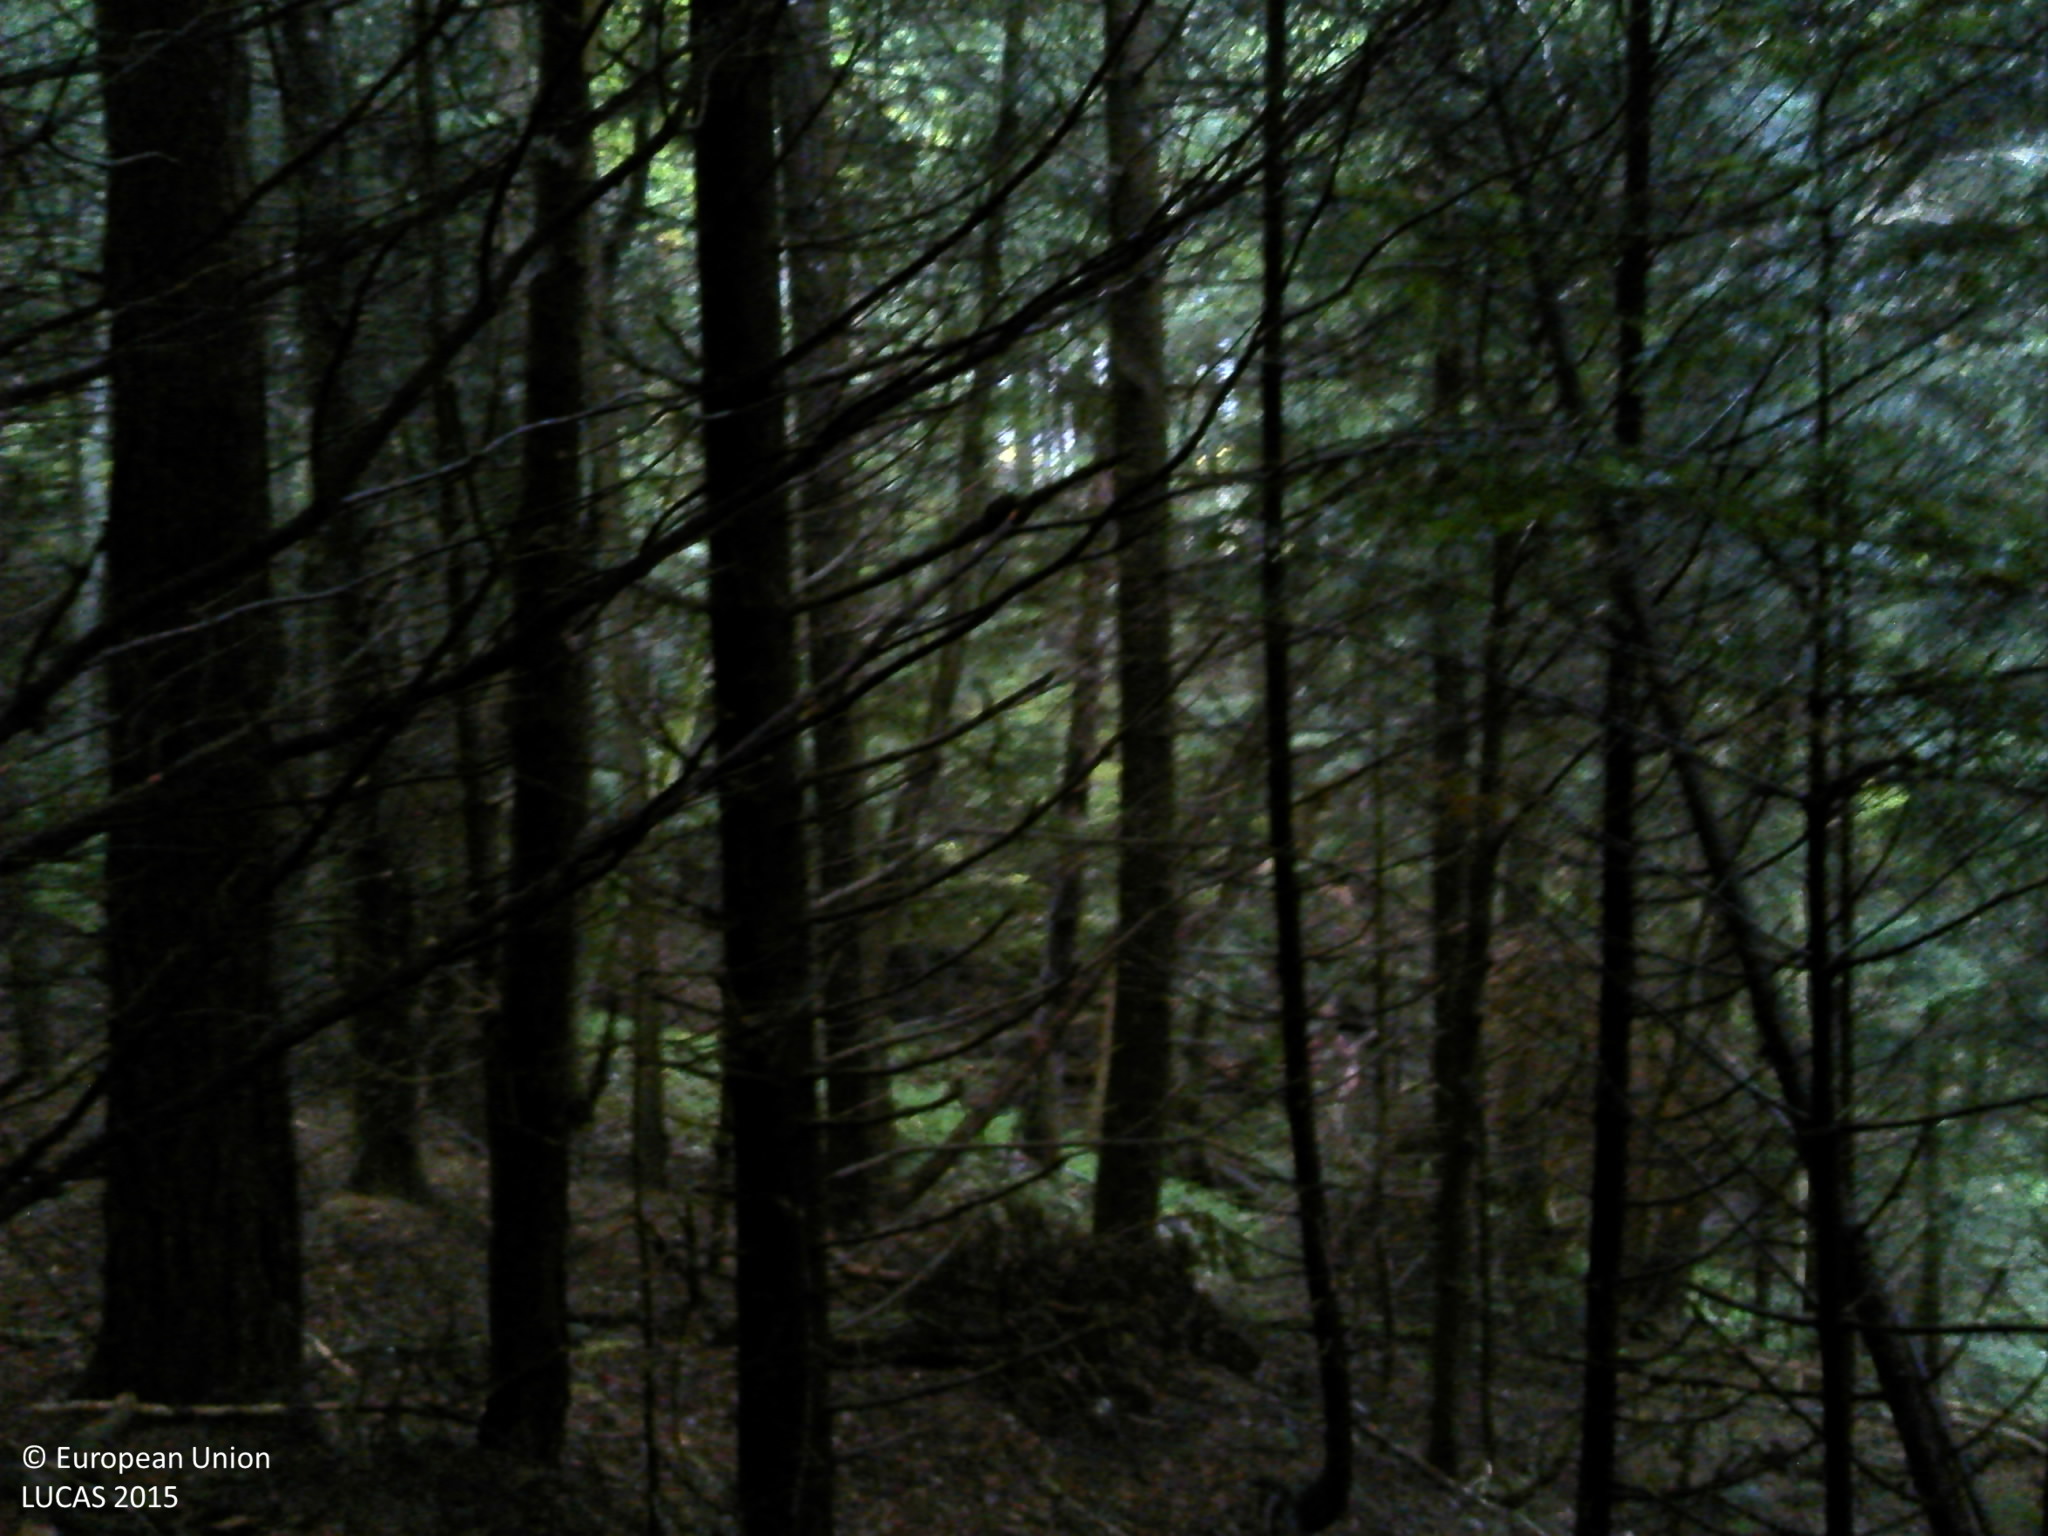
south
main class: Woodland
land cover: Pine dominated mixed woodland
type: mountainous beech forest
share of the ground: > 75 %
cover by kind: coniferous forest trees 50 %, broadleaved forest trees 40 %, unconsolidated bare surface 10 %
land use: Forestry
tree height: > 5 m
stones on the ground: 10 - 25 %
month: October
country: FR
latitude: 45.3754
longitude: 3.7841
